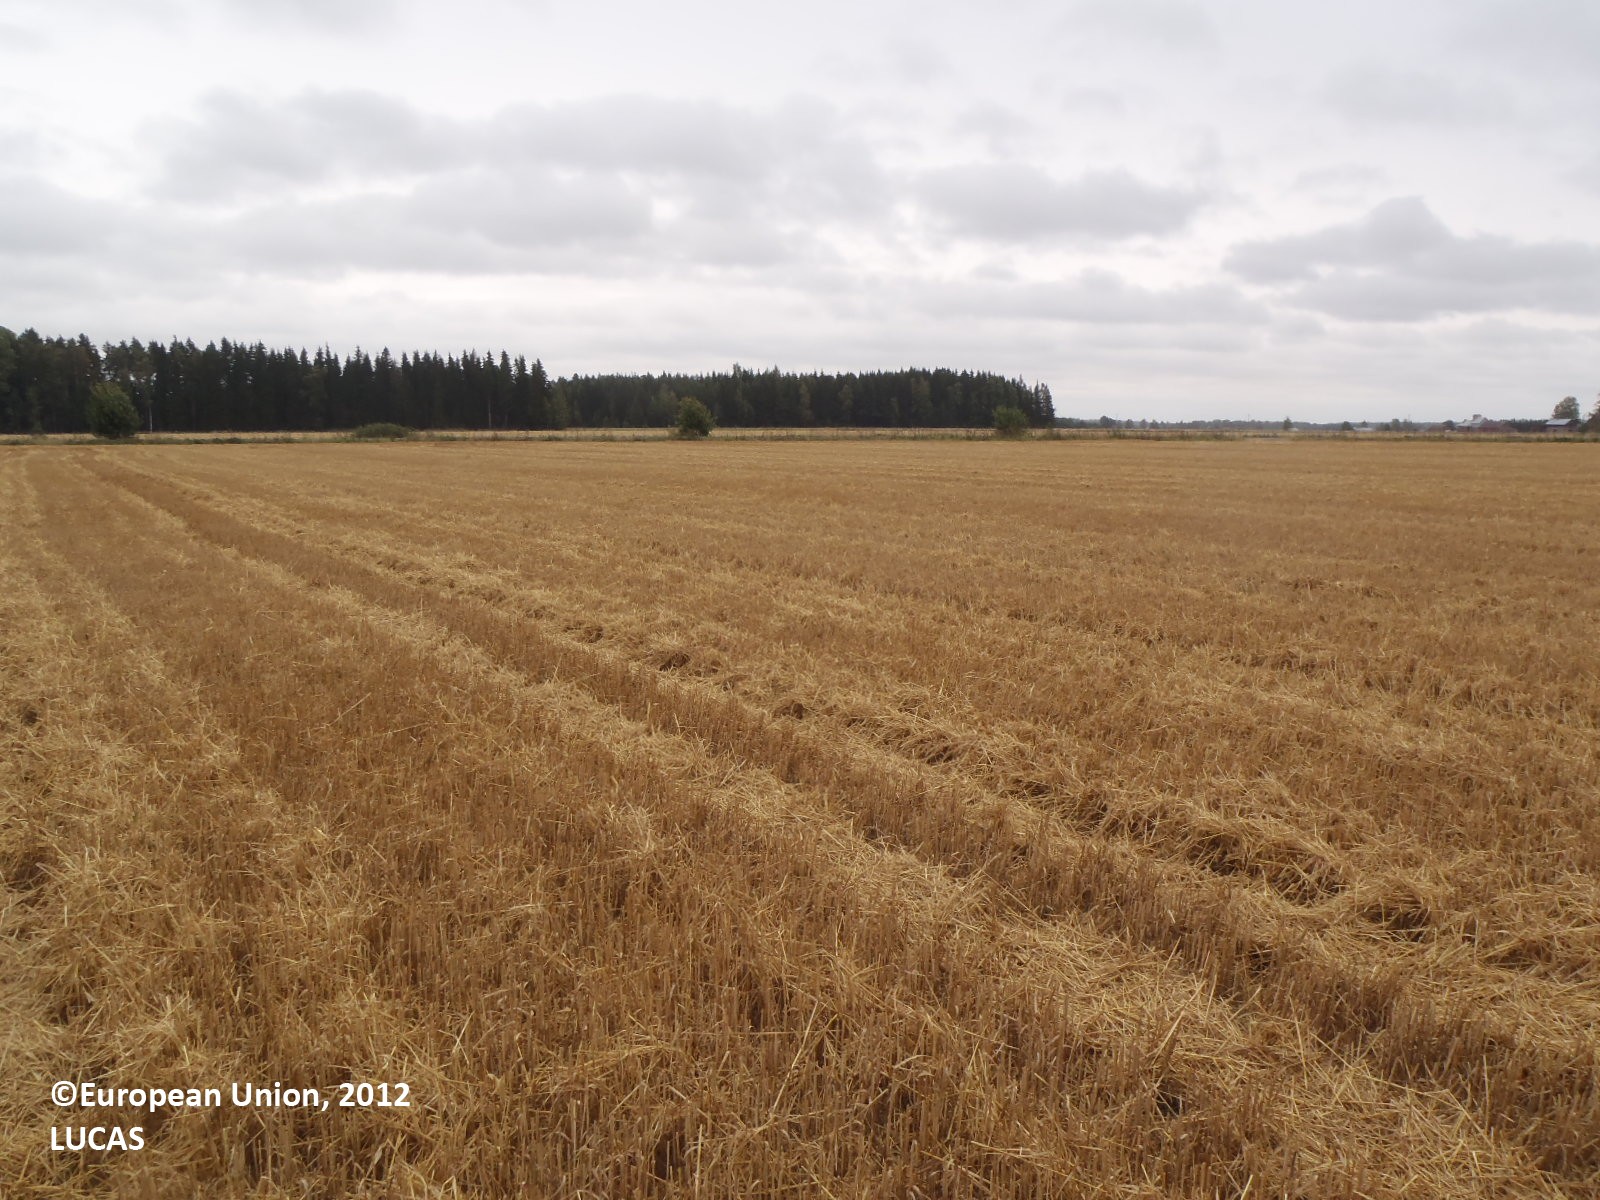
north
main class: Cropland
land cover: Barley
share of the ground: 50 - 75 %
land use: Agriculture (excluding fallow land and kitchen gardens)
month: September
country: FI
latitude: 60.8145
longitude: 22.8503
